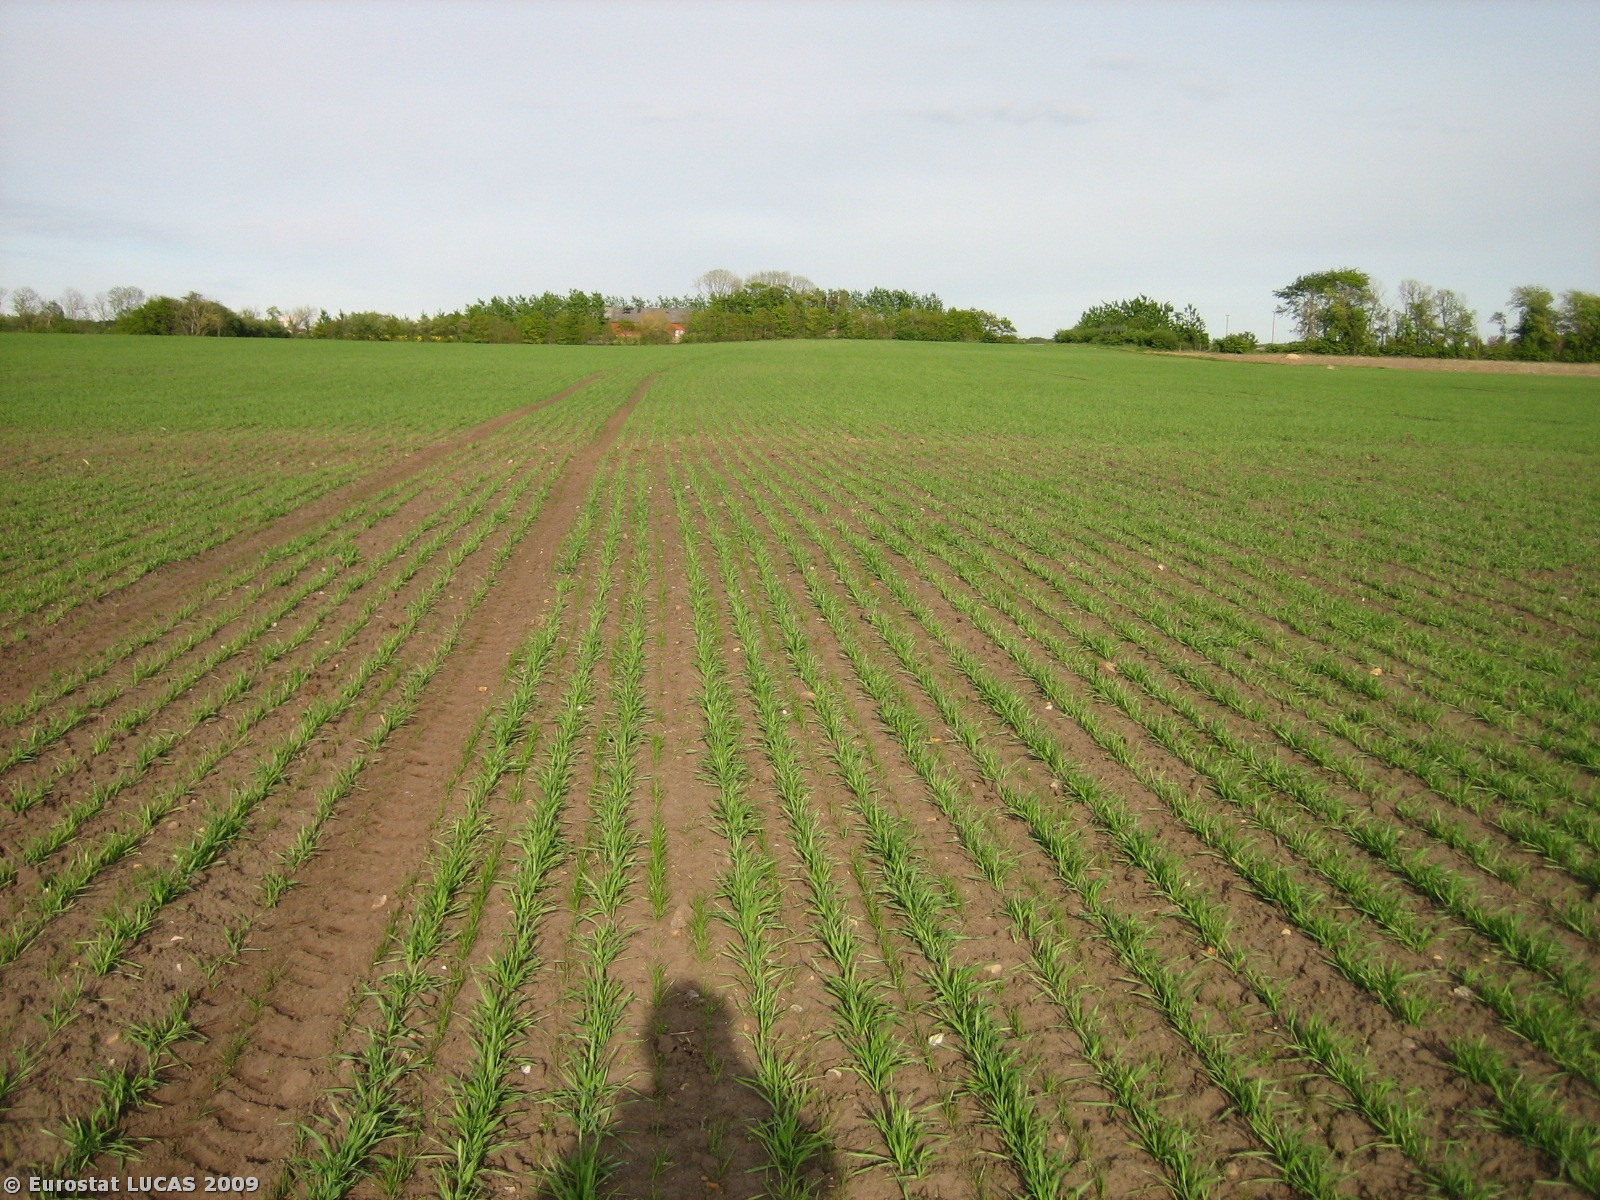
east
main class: Cropland
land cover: Barley
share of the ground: 25 - 50 %
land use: Agriculture (excluding fallow land and kitchen gardens)
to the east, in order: Barley
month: May
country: DK
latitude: 56.1060
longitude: 8.4099
